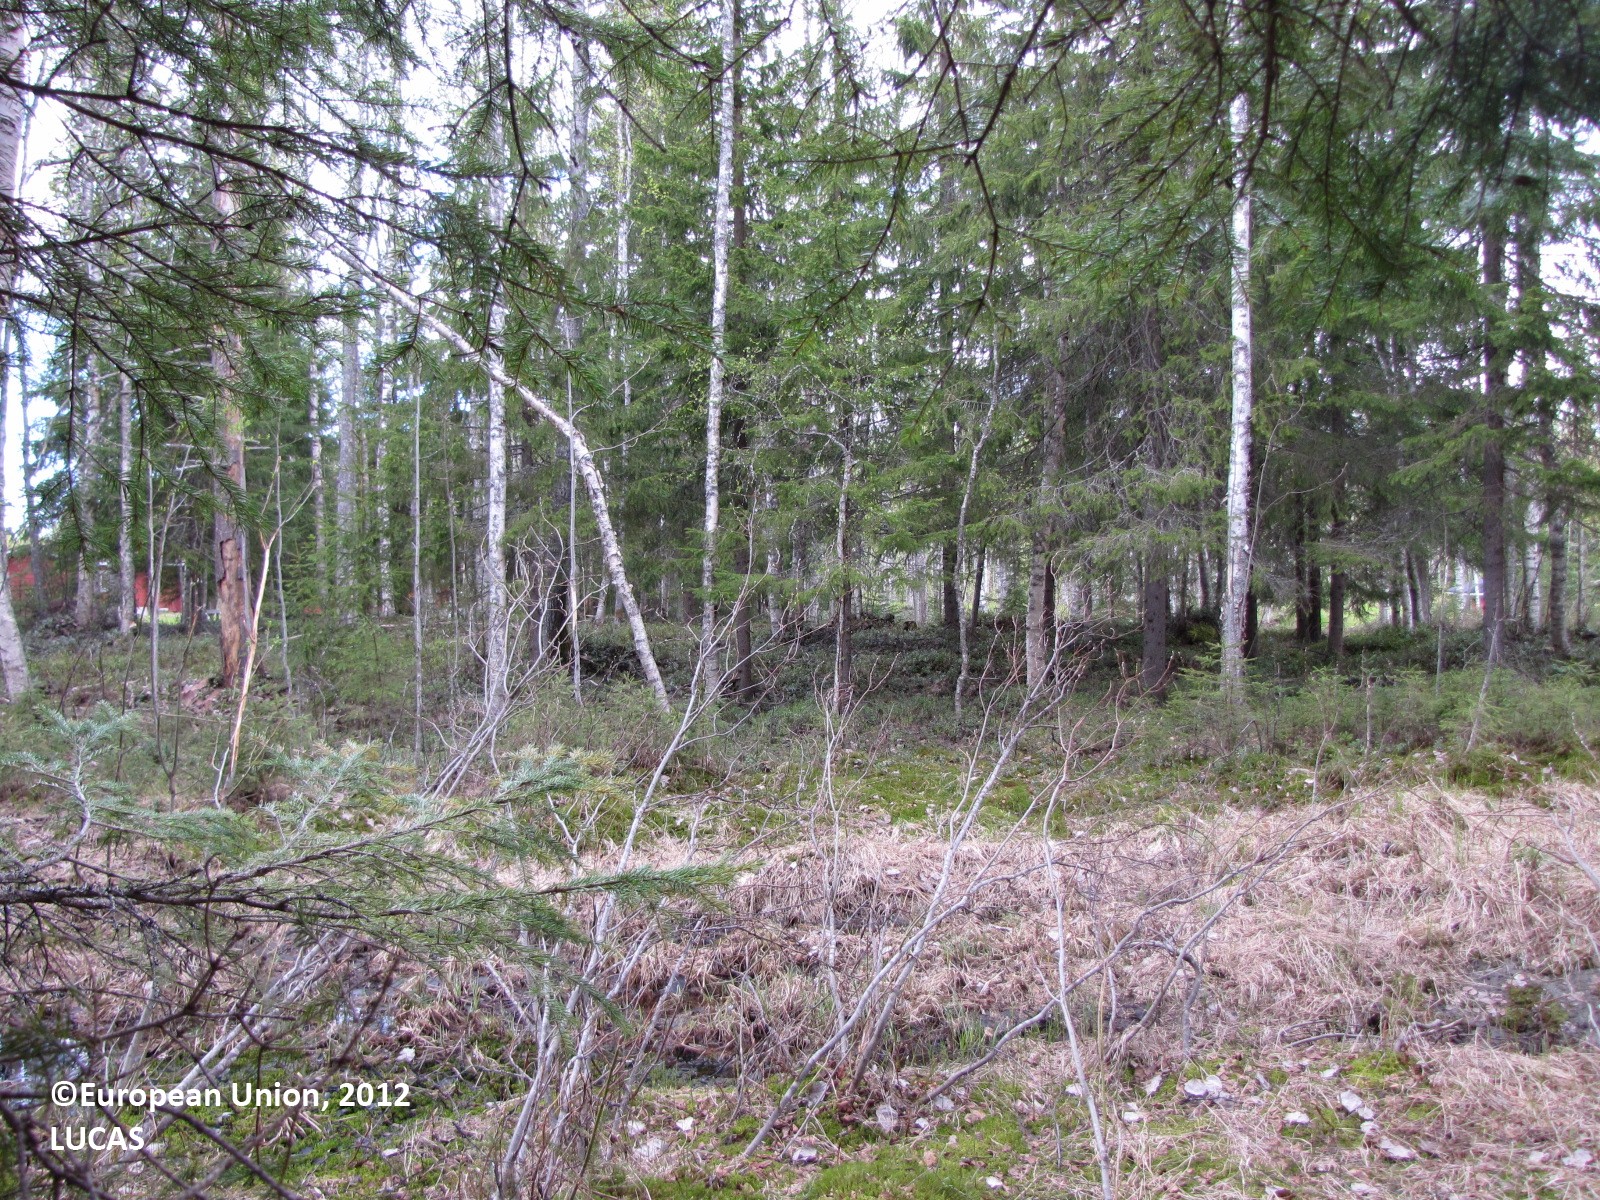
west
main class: Woodland
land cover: Spruce dominated mixed woodland
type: boreal forest
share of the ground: 50 - 75 %
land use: Forestry
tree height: > 5 m
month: June
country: FI
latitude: 65.8173
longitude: 24.6481
